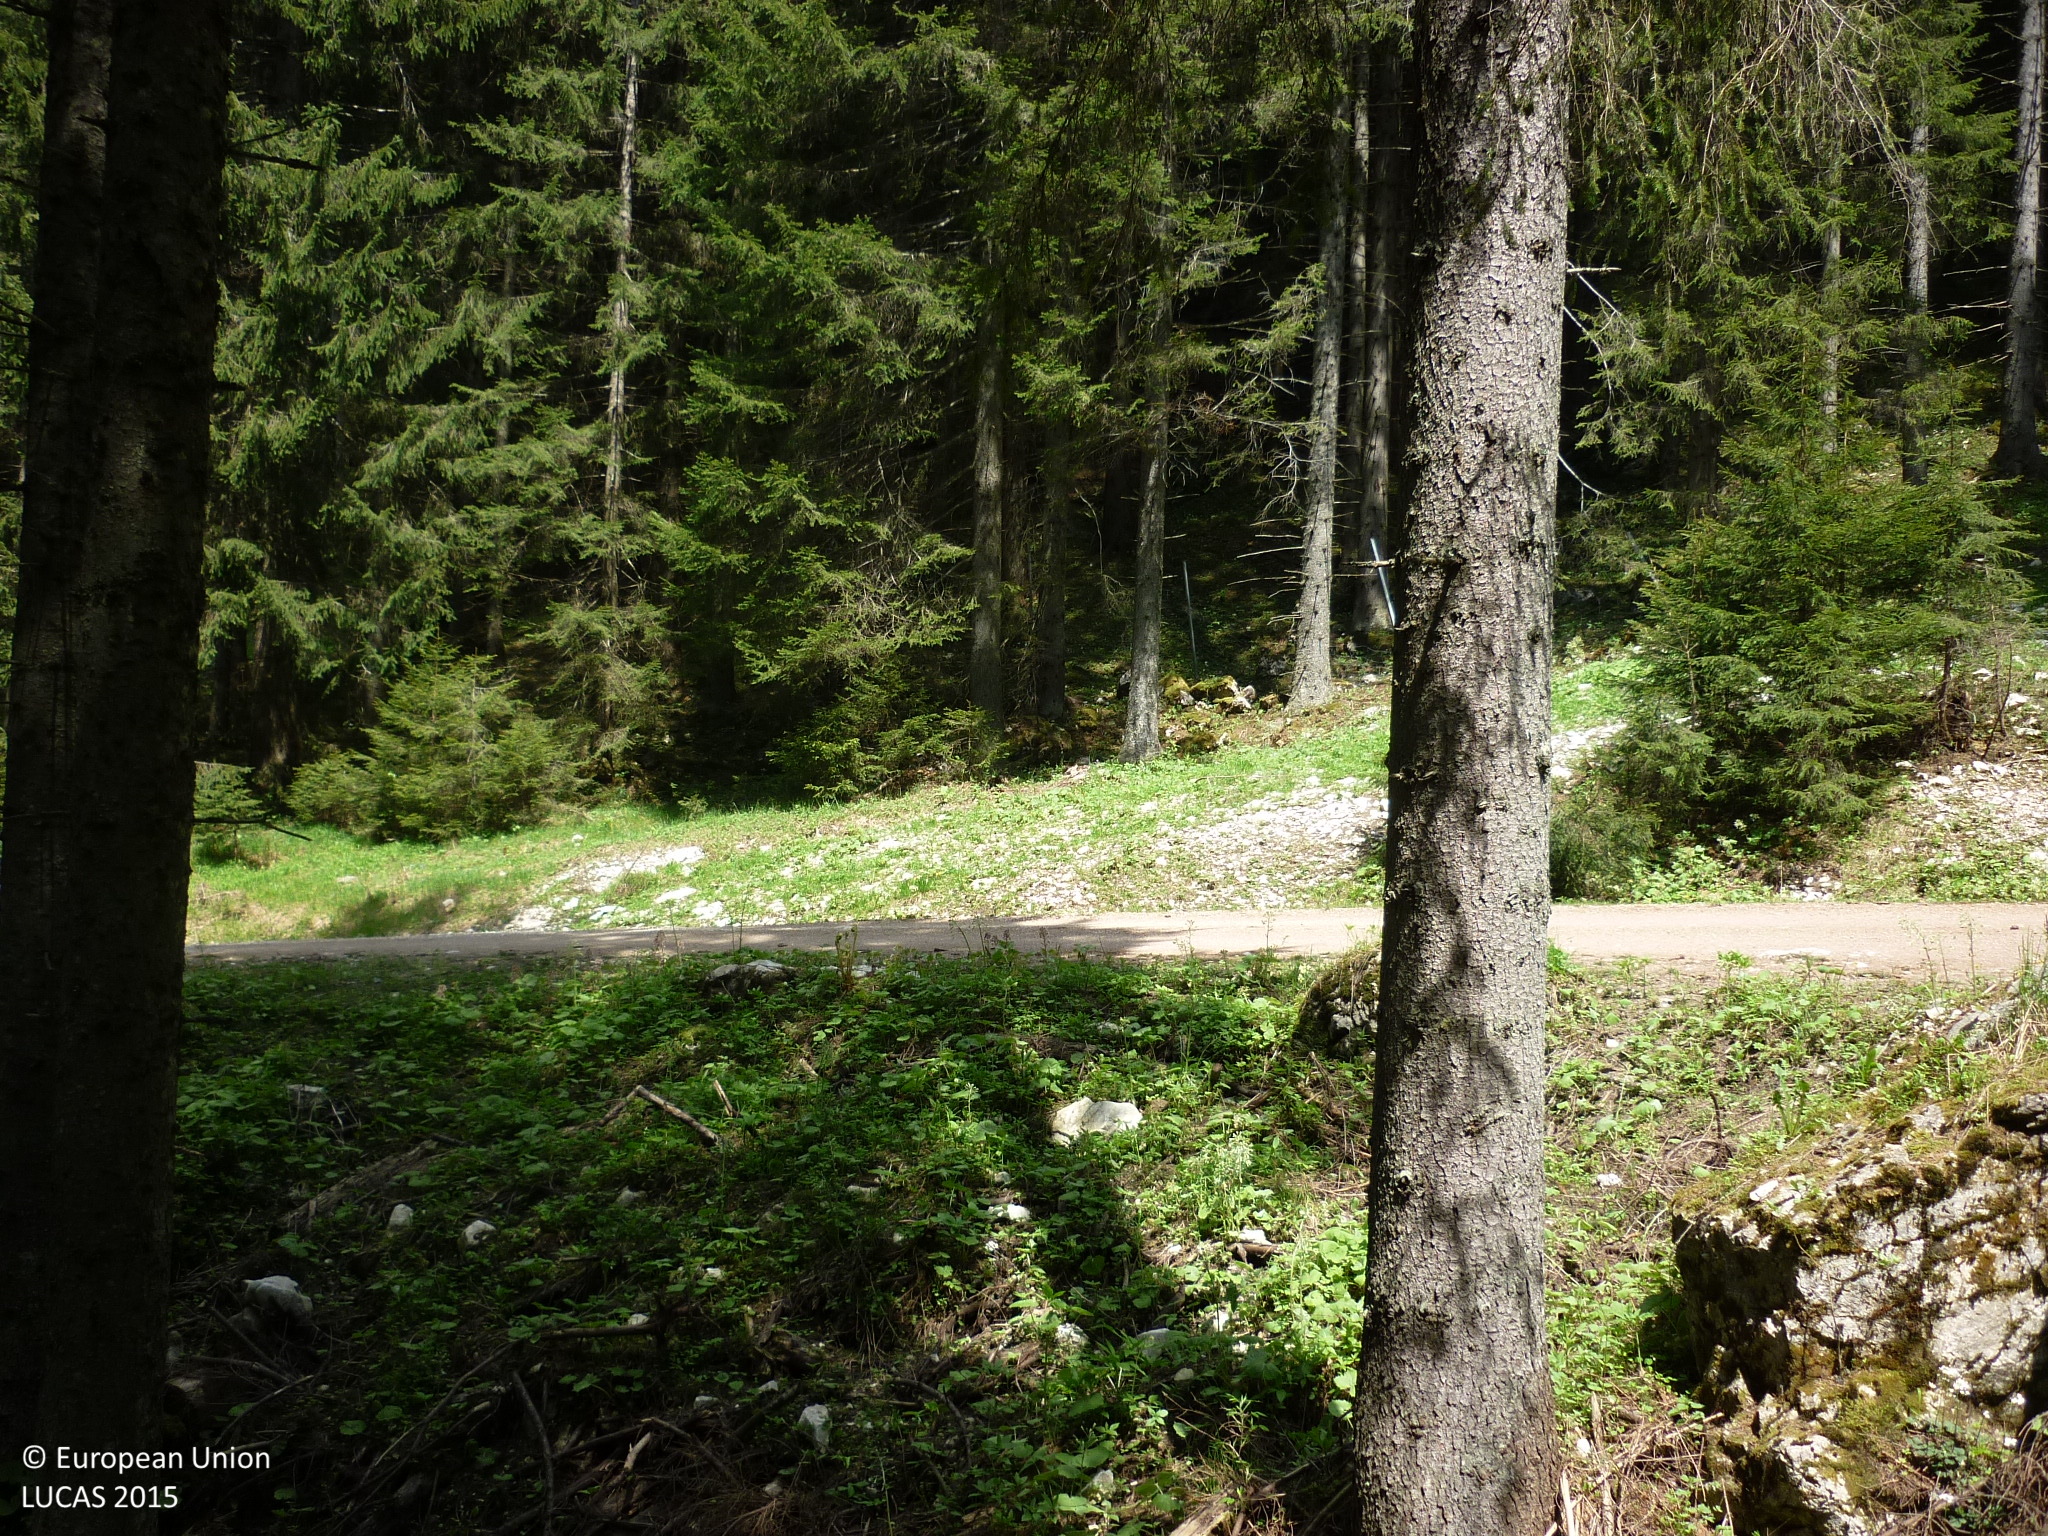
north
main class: Woodland
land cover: Spruce dominated coniferous woodland
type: alpine coniferous forest
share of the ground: > 75 %
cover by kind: coniferous forest trees 85 %, herbaceous plants 15 %
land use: Forestry
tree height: > 5 m
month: May
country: AT
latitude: 47.5532
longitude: 14.9566
